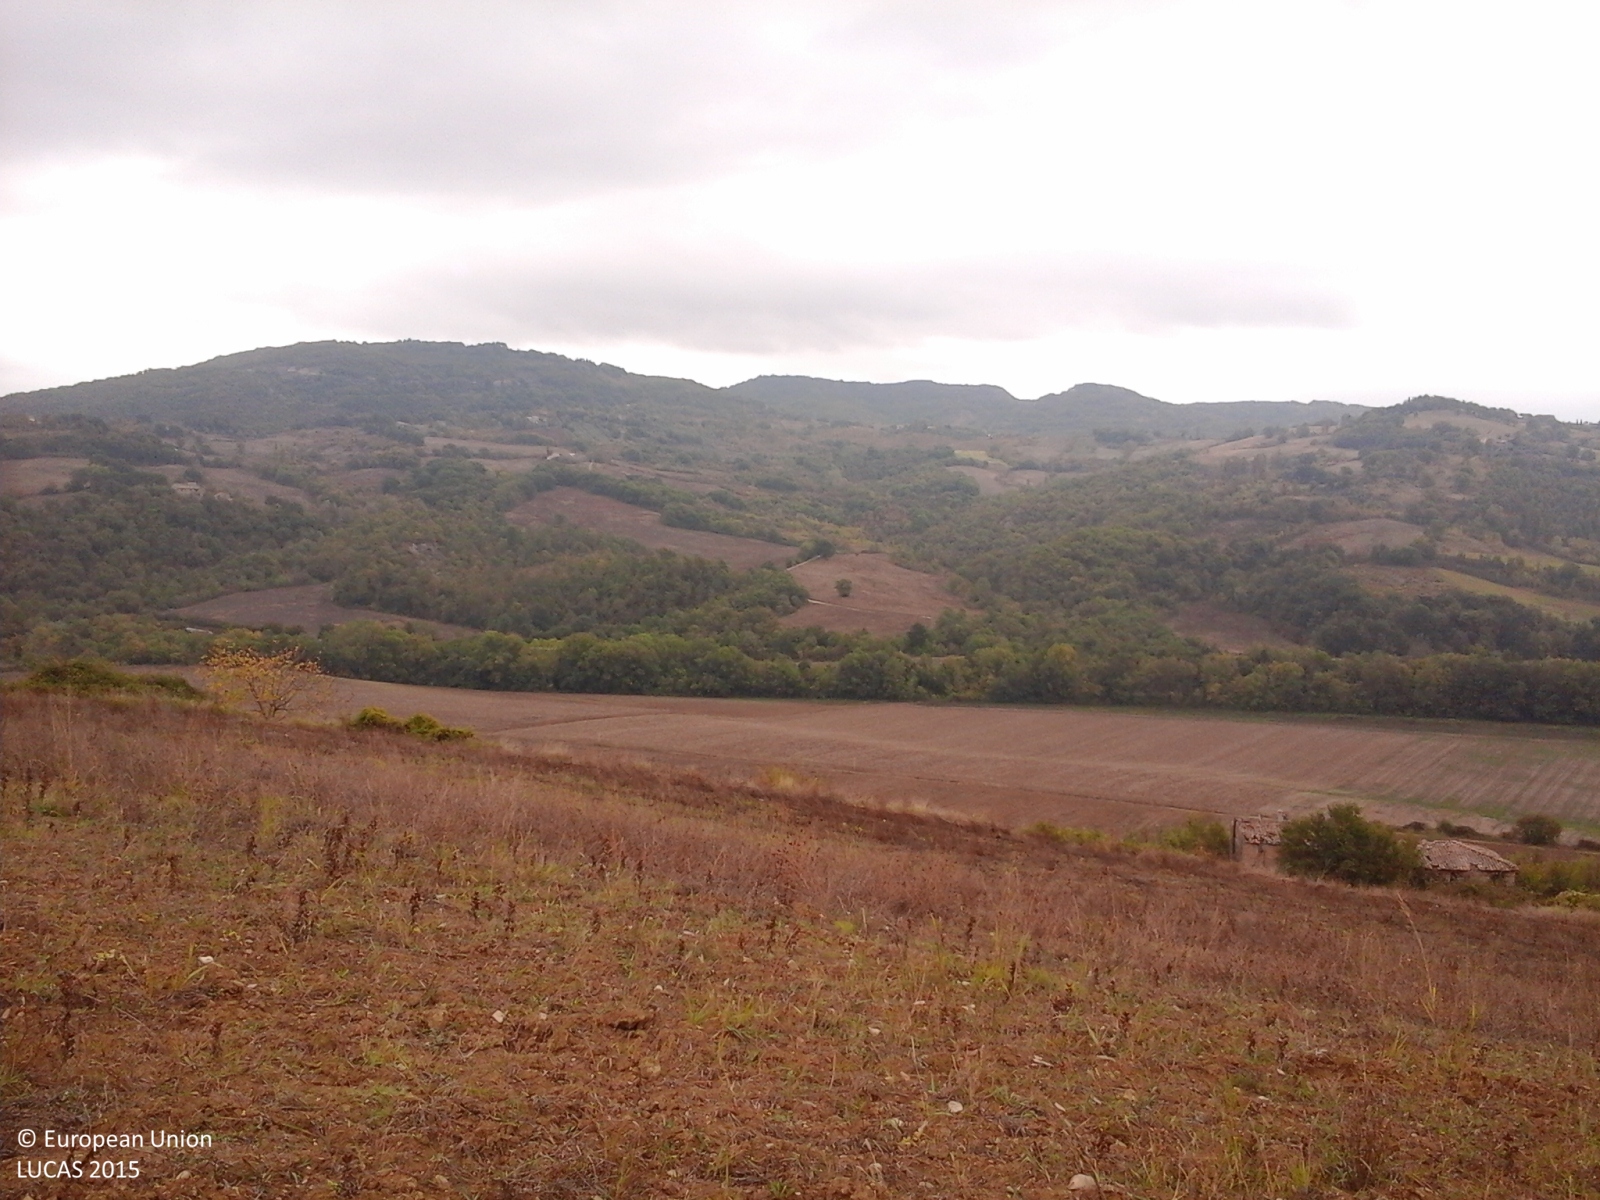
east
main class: Grassland
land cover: Spontaneously vegetated surfaces
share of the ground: 50 - 75 %
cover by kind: herbaceous plants 50 %, consolidated bare surface 35 %, unconsolidated bare surface 15 %
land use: Fallow land
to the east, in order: Spontaneously vegetated surfaces; Shrubland with sparse tree cover; Broadleaved woodland; Other bare soil; Electric lines; Other bare soil
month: October
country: IT
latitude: 43.3126
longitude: 12.3730
